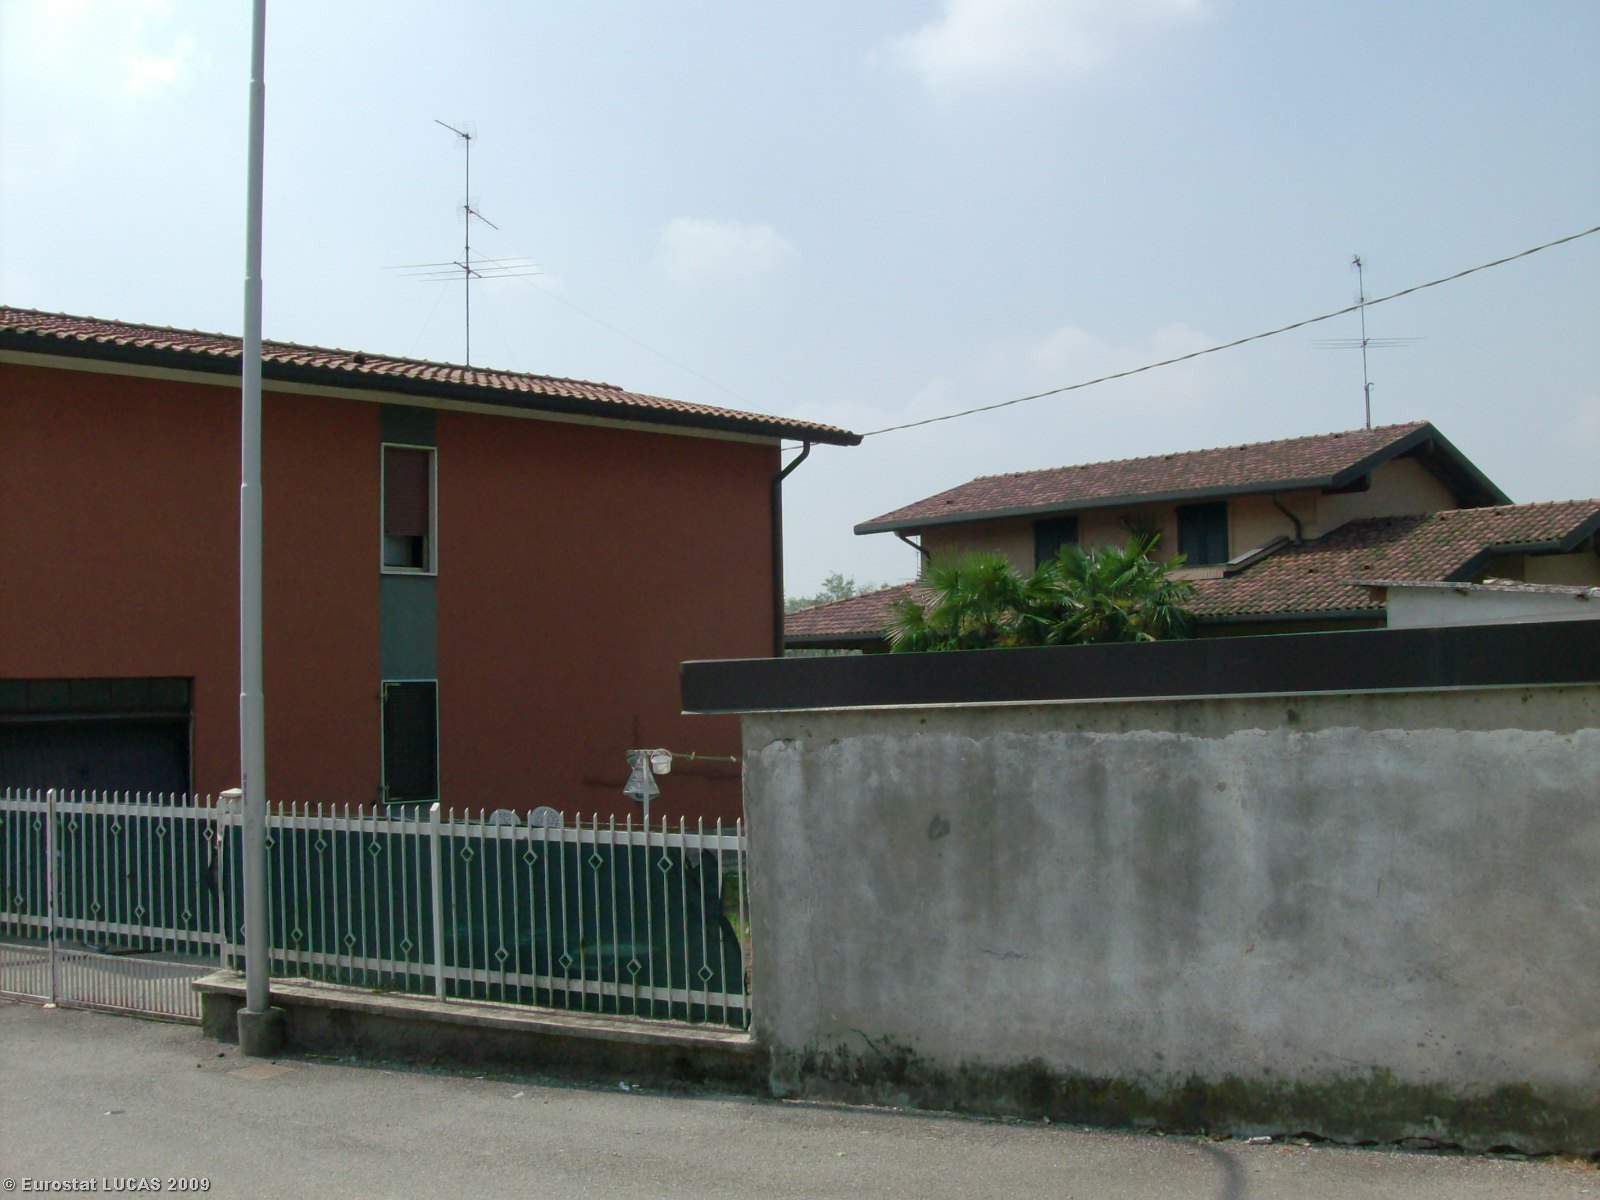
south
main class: Grassland
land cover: Grassland with sparse tree/shrub cover
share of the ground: > 75 %
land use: Residential
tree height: < 5 m
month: May
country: IT
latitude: 45.6655
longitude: 9.5259
